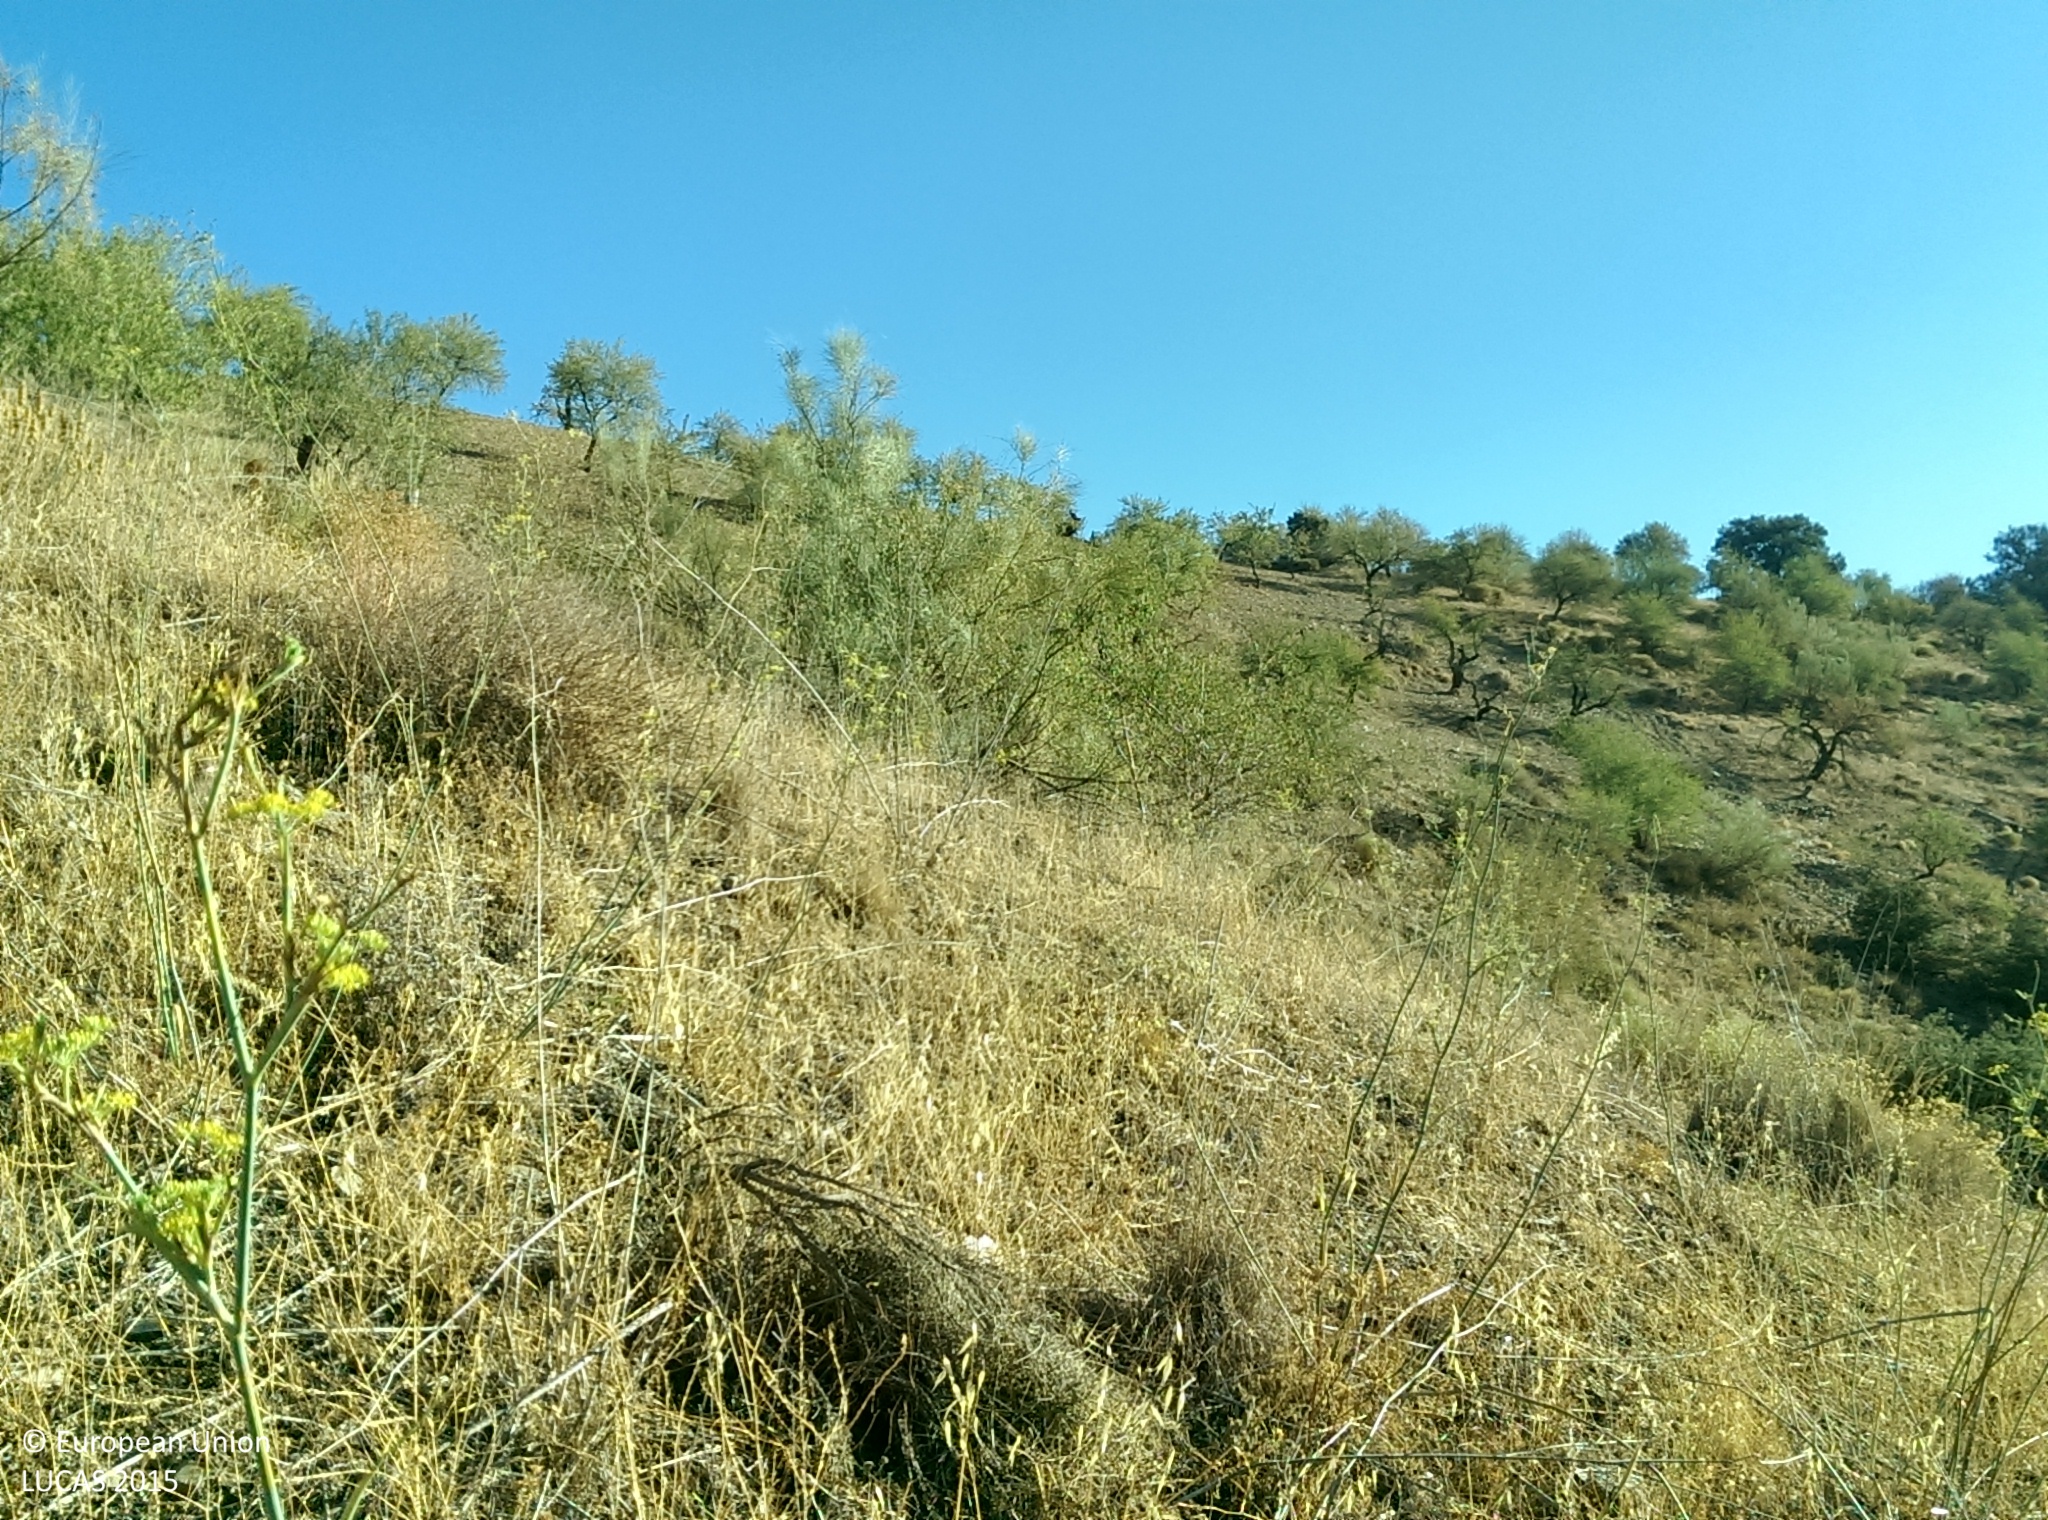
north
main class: Grassland
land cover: Grassland without tree/shrub cover
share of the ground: > 75 %
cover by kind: herbaceous plants 100 %
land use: Abandoned areas
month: August
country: ES
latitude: 36.8862
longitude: -3.1420
